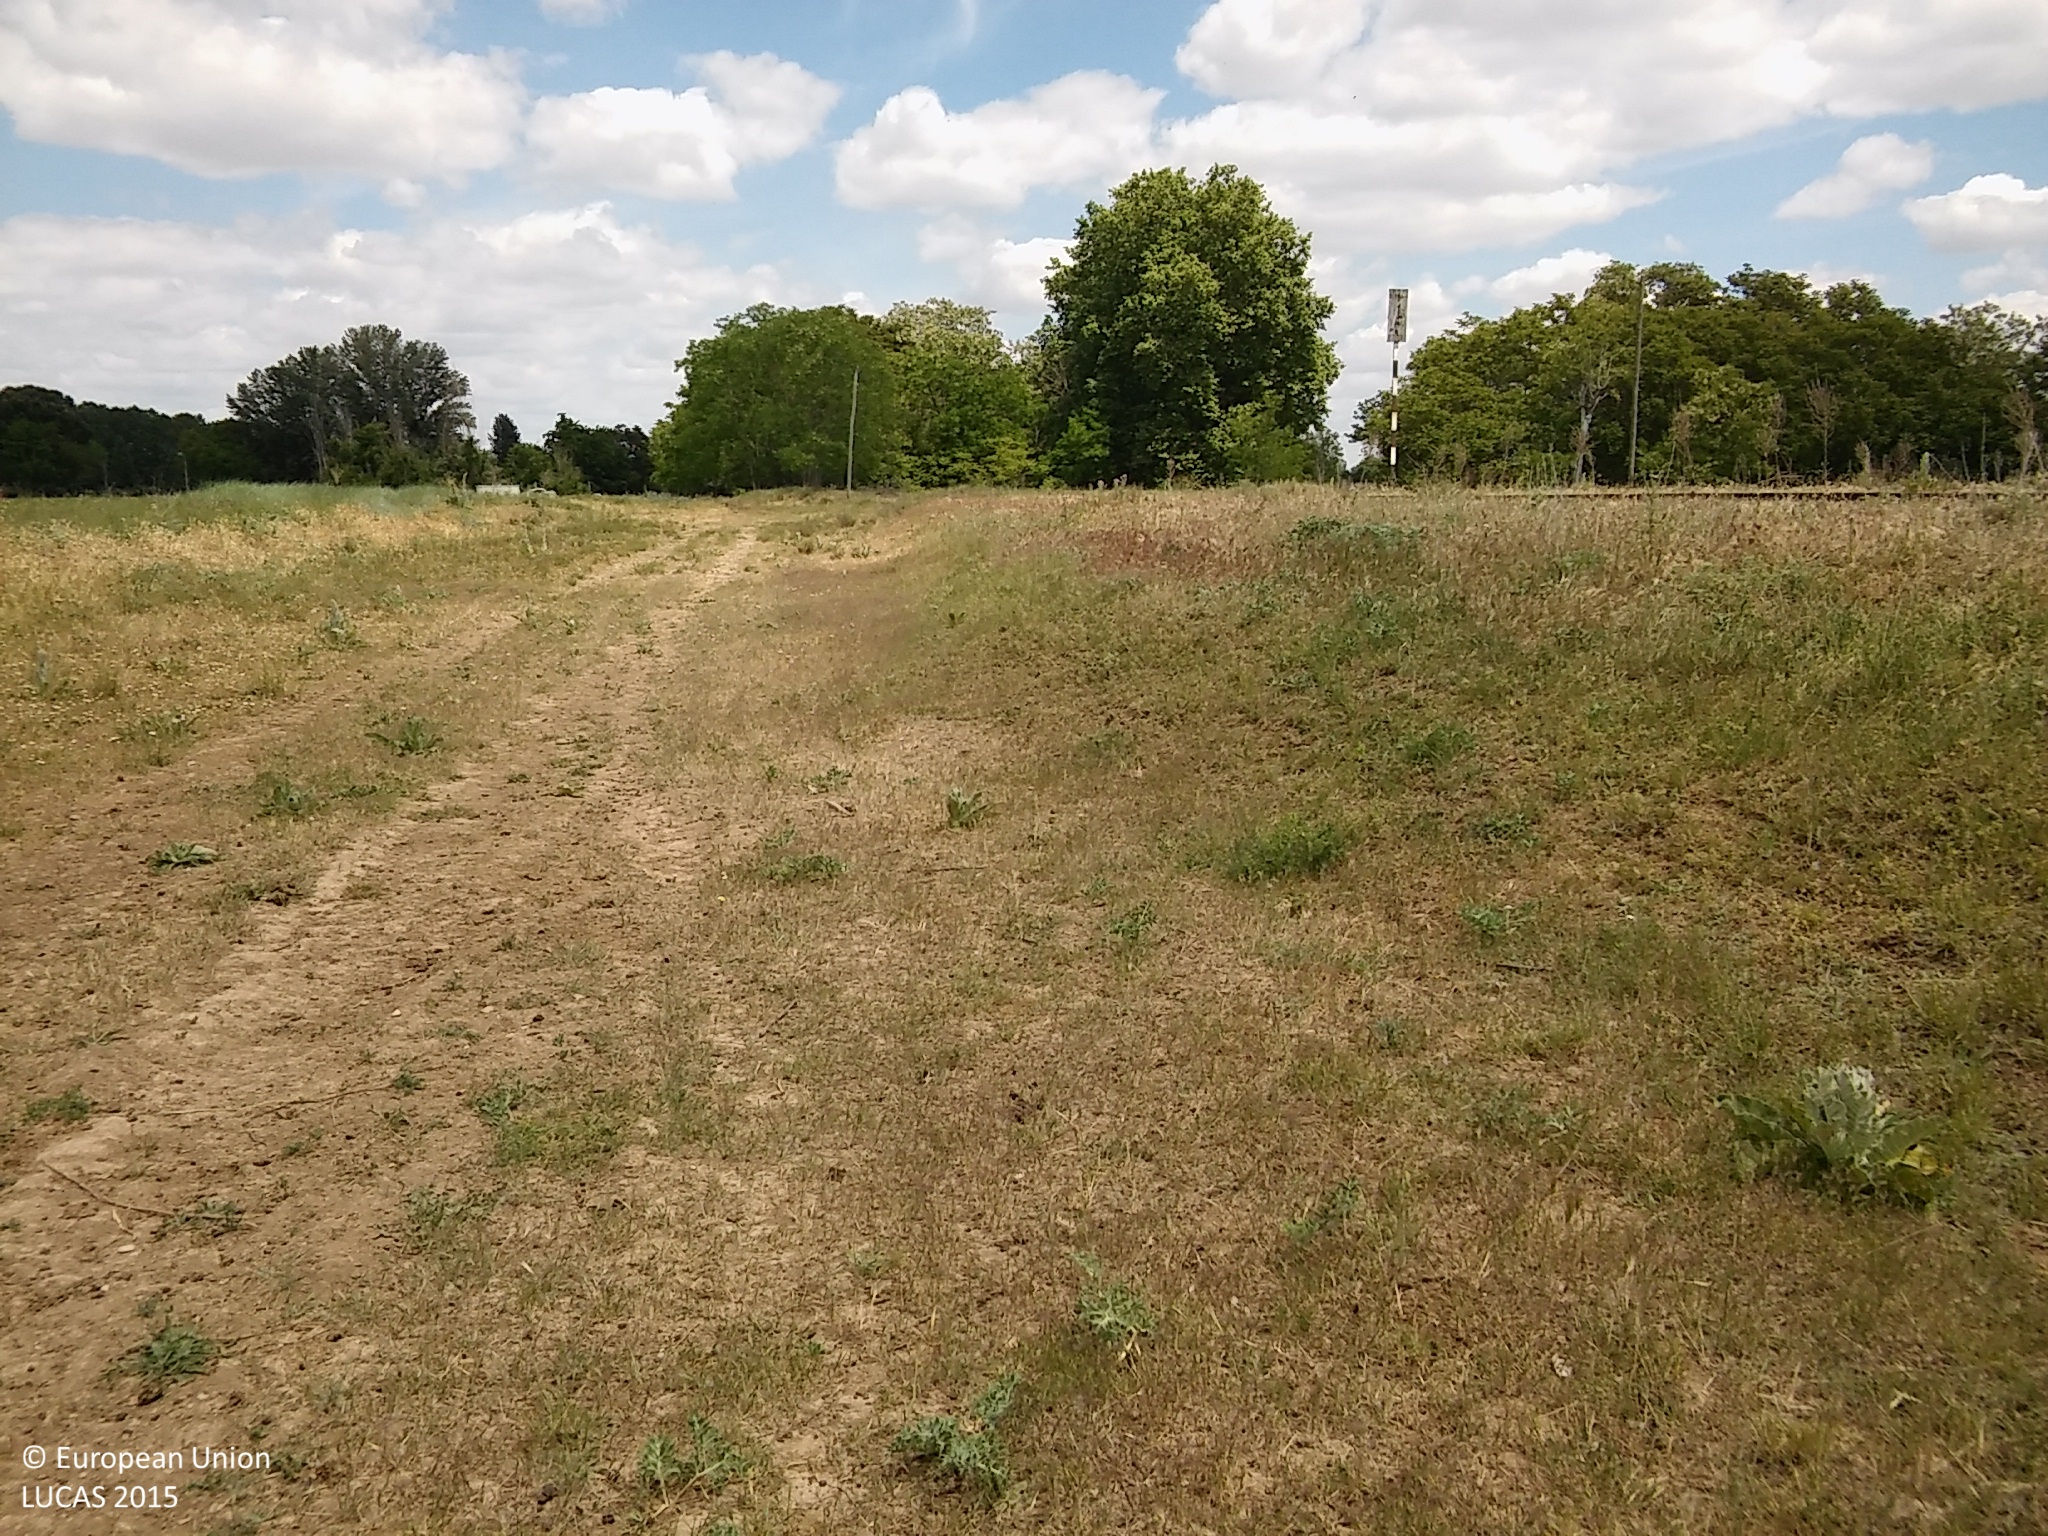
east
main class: Grassland
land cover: Grassland without tree/shrub cover
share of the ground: 50 - 75 %
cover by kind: herbaceous plants 60 %, unconsolidated bare surface 40 %
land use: Agriculture (excluding fallow land and kitchen gardens)
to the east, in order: Grassland without tree/shrub cover; Tracks; Grassland without tree/shrub cover; Broadleaved woodland; Artificial constructions in urban areas; Tracks
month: May
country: ES
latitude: 41.6430
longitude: -3.5816
